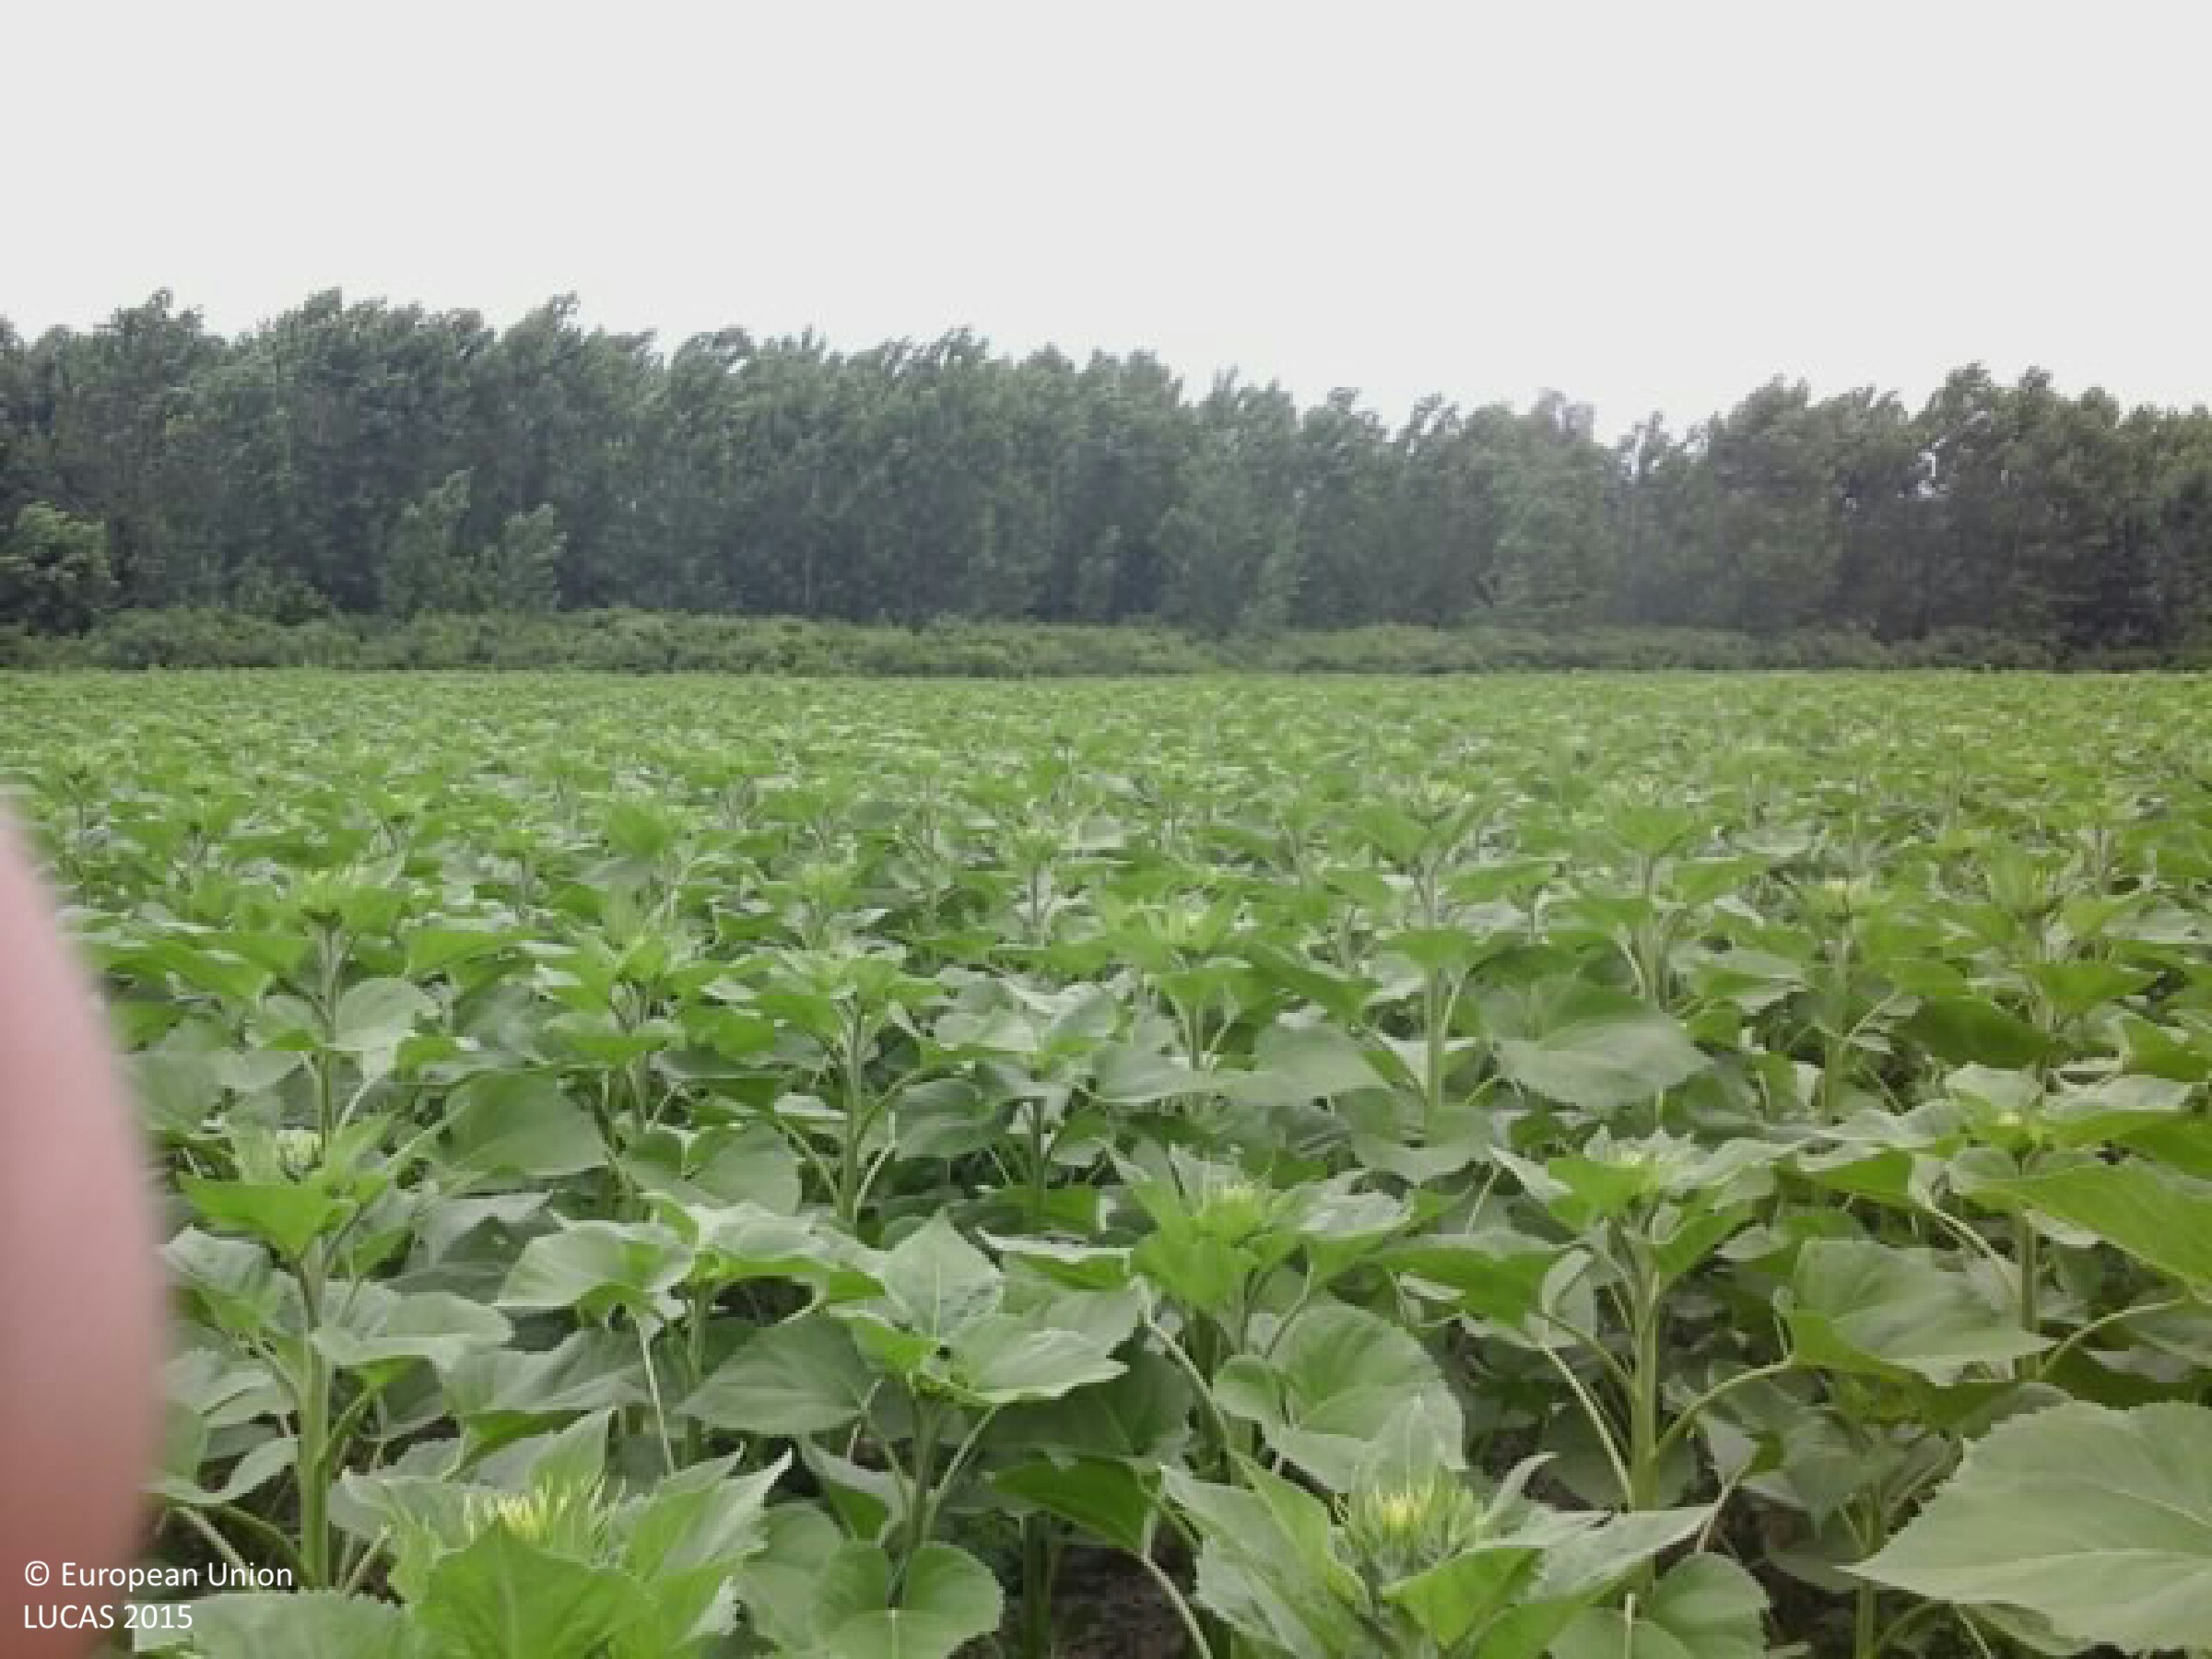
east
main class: Cropland
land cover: Sunflower
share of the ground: > 75 %
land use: Agriculture (excluding fallow land and kitchen gardens)
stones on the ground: < 10 %
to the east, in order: Sunflower; Shrubland without tree cover; Broadleaved woodland; Grass margins; Paved roads, cycling and walking lanes; Grass margins; Artificial constructions in urban areas; Inland fresh running water; Paved roads, cycling and walking lanes
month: June
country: HU
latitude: 46.1758
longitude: 18.9369
